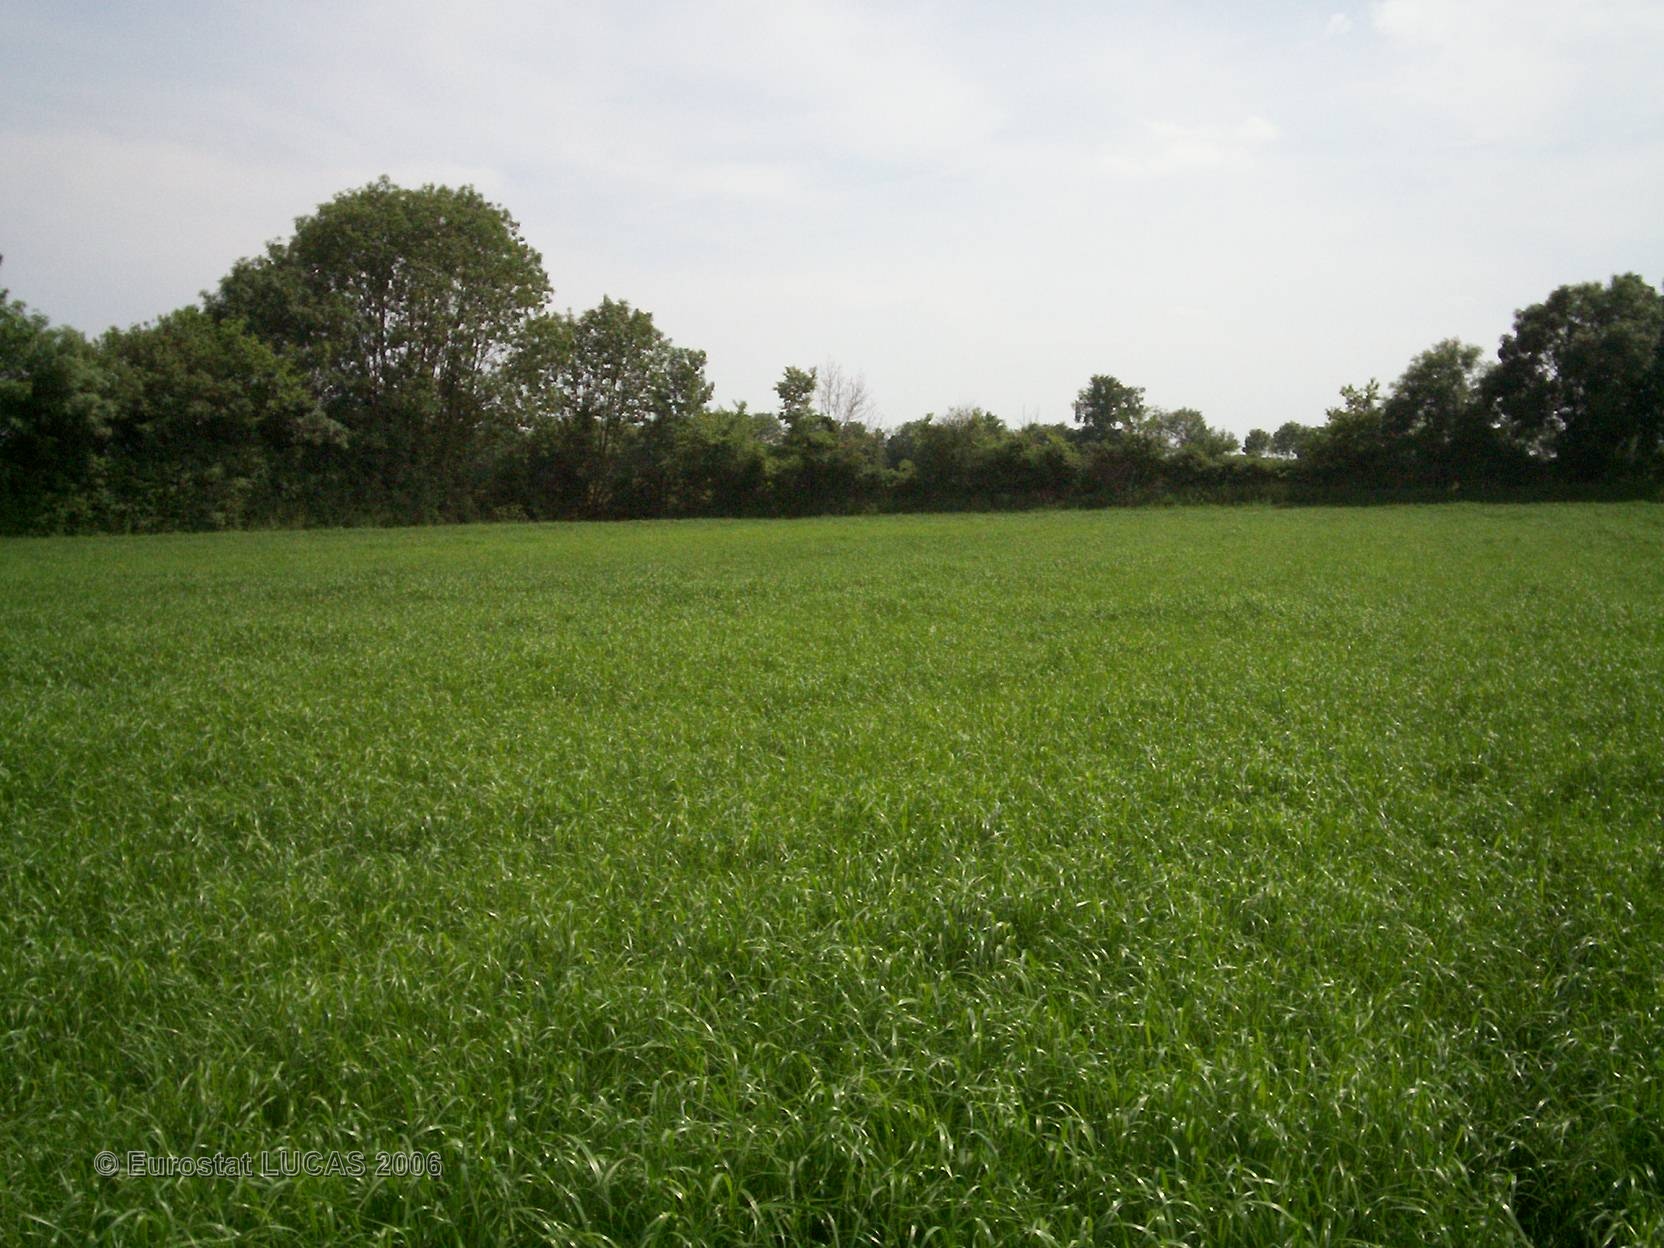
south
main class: Grassland
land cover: Grassland without tree/shrub cover
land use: Agriculture (excluding fallow land and kitchen gardens)
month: May
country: FR
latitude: 46.4520
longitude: -0.2961
